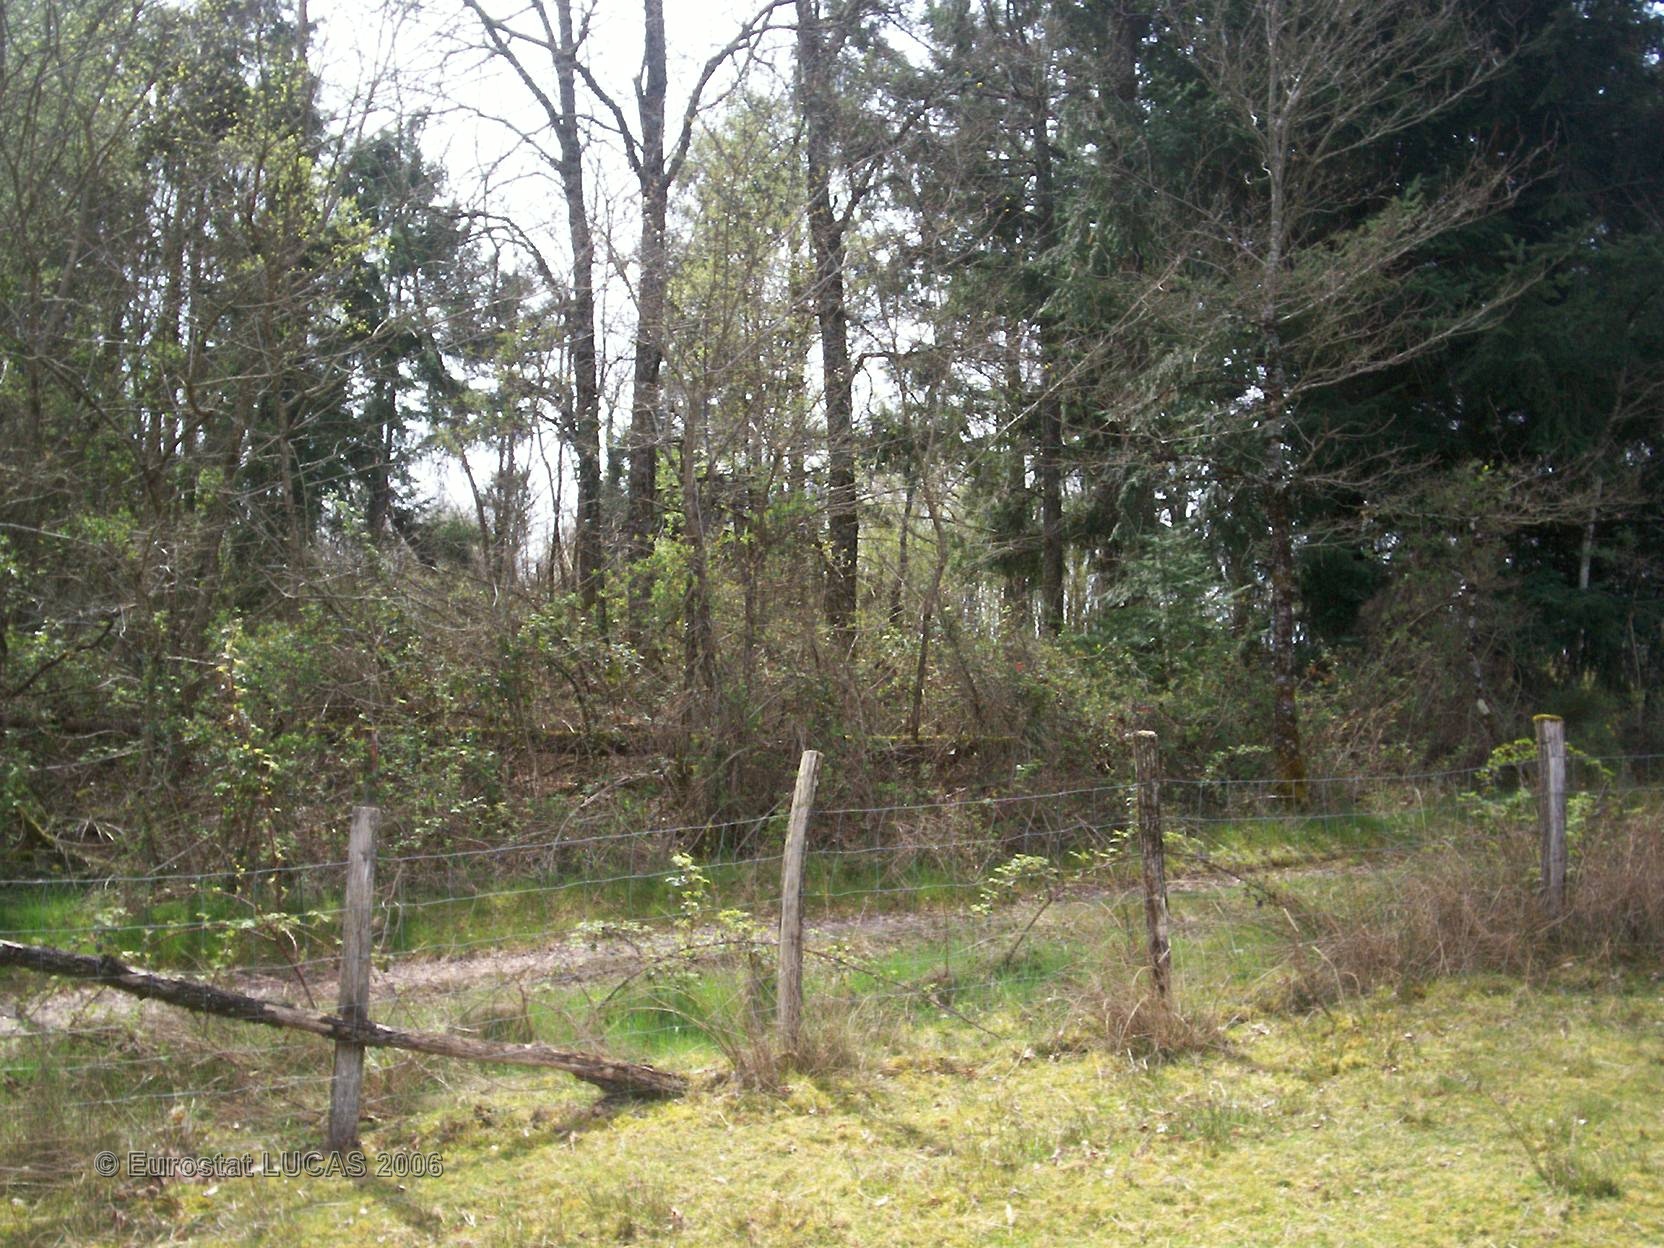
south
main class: Grassland
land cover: Grassland without tree/shrub cover
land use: Agriculture (excluding fallow land and kitchen gardens)
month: April
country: FR
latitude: 45.1811
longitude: 1.3020
